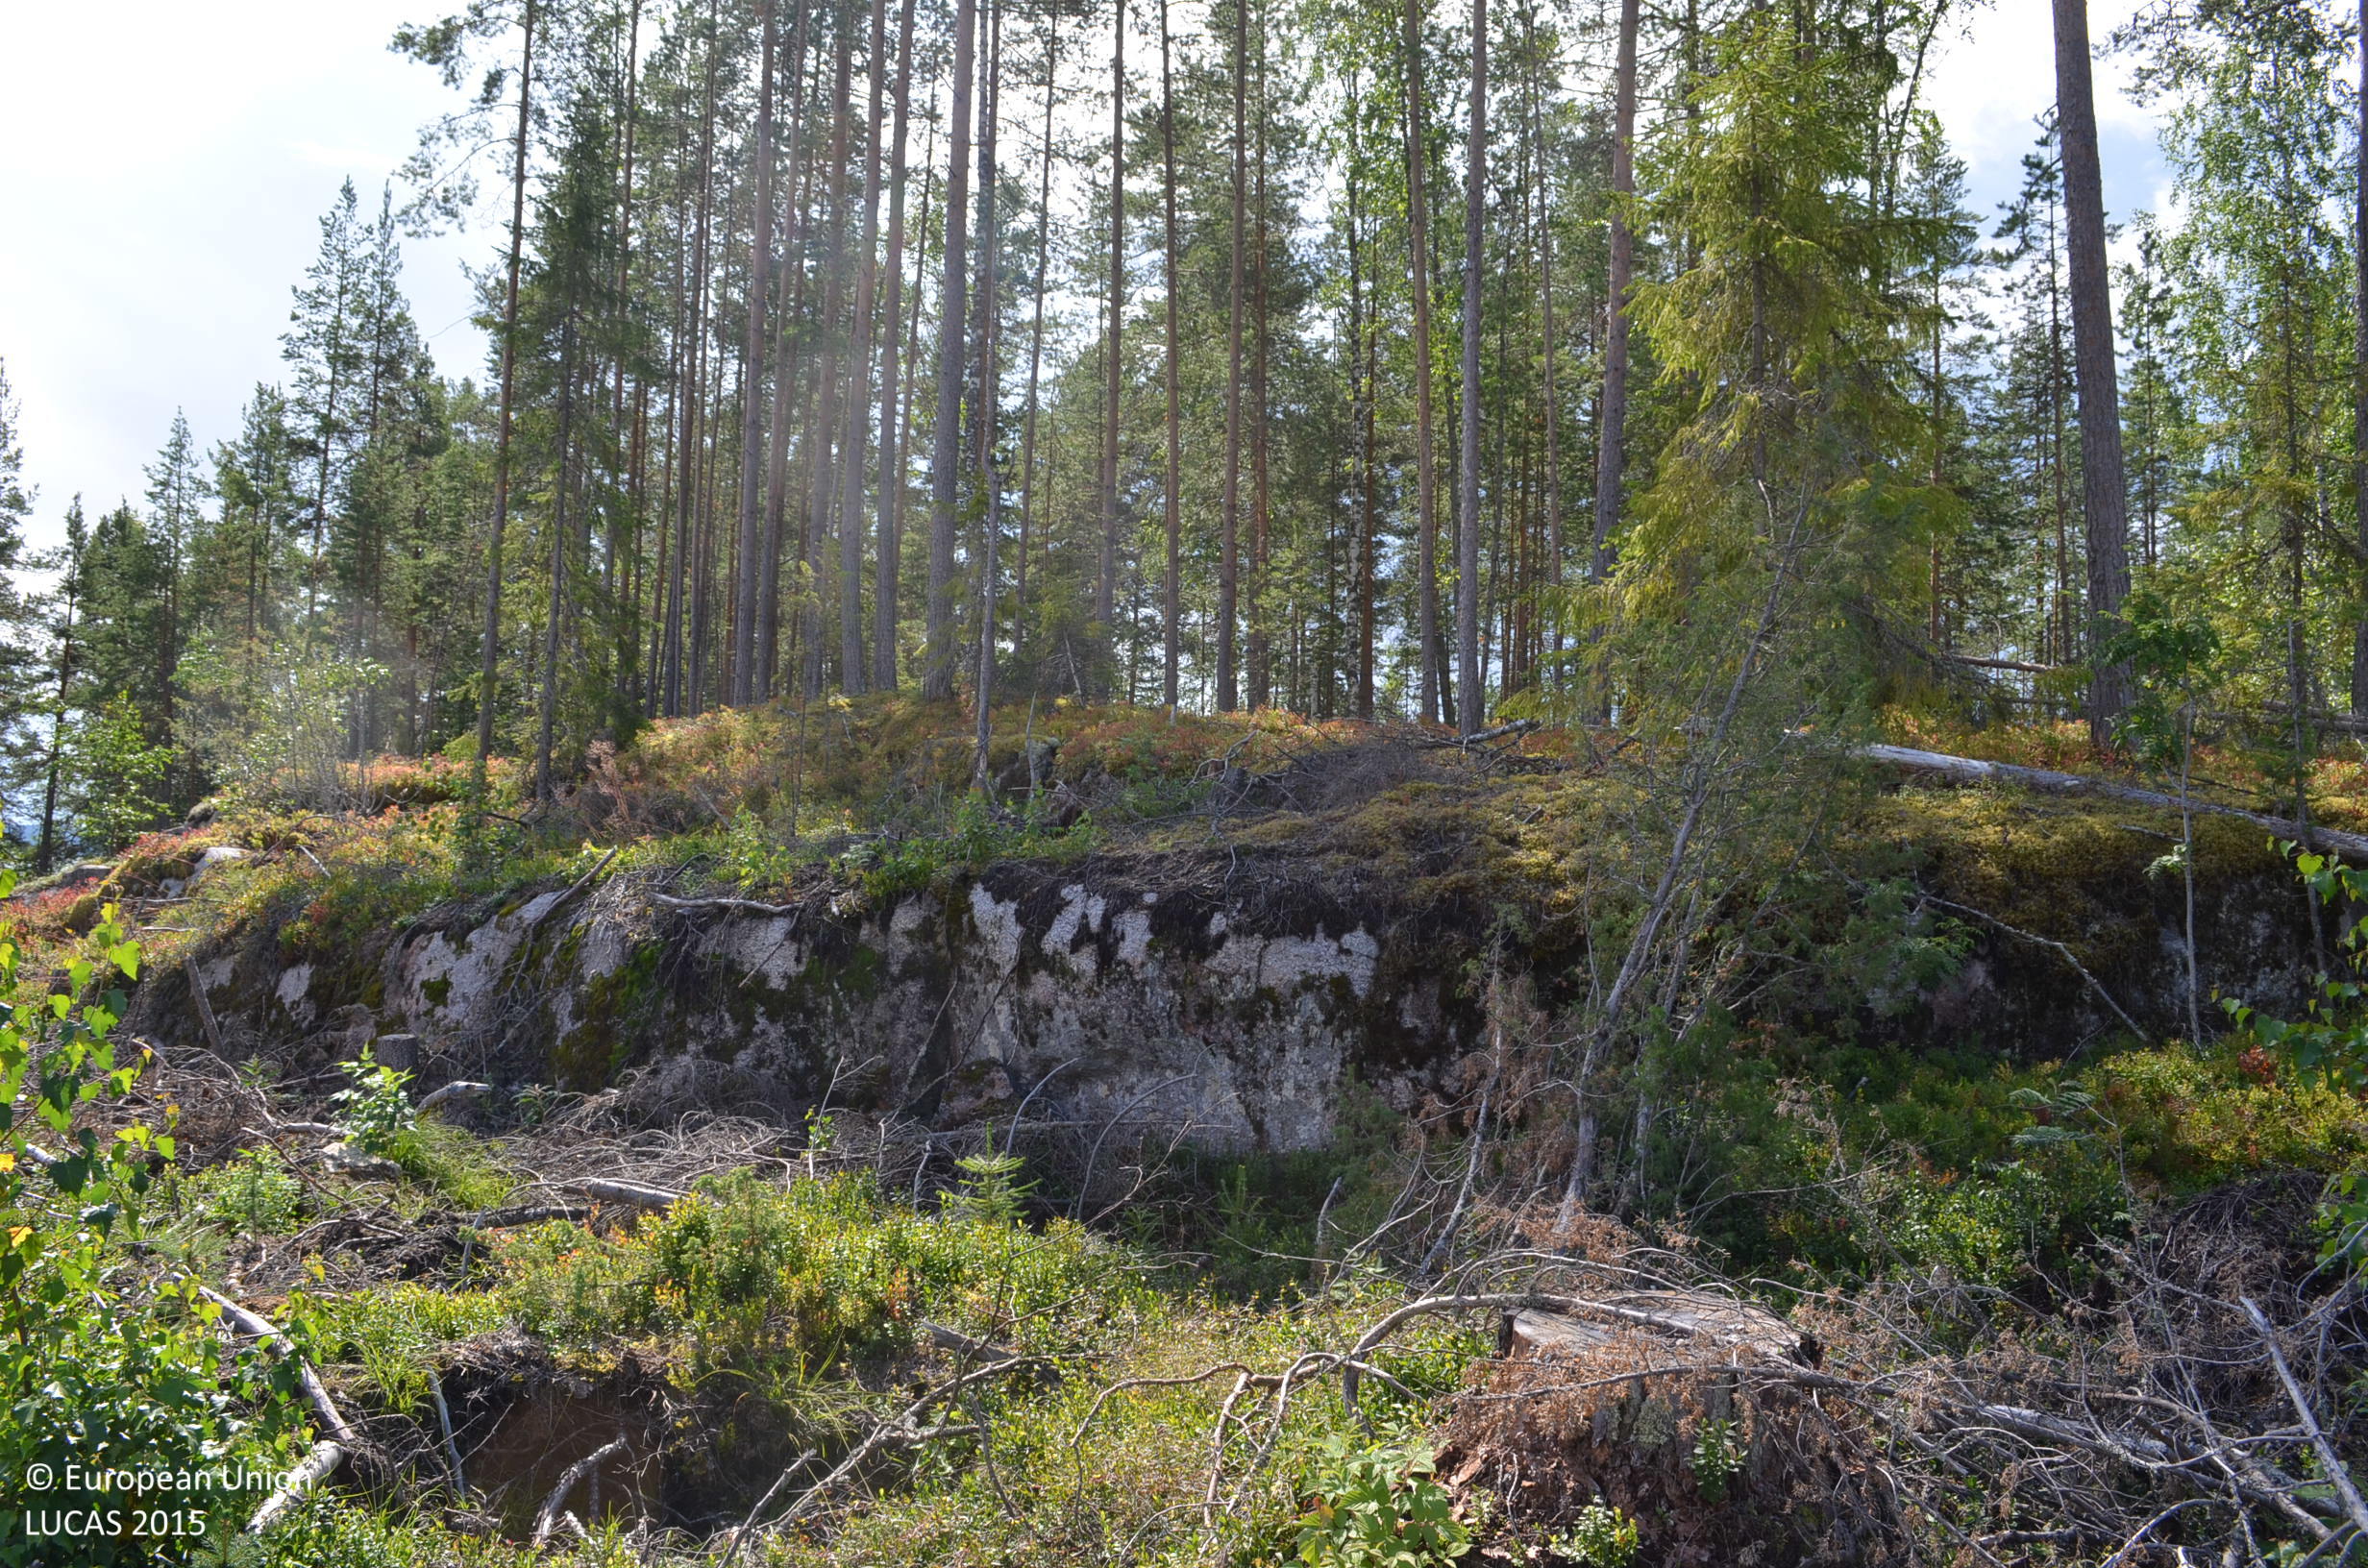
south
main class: Shrubland
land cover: Shrubland with sparse tree cover
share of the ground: 25 - 50 %
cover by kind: shrubs 40 %, herbaceous plants 15 %, consolidated bare surface 15 %, broadleaved forest trees 5 %
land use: Forestry
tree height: < 5 m
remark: Clear cut
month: July
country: FI
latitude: 61.9975
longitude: 24.1195
